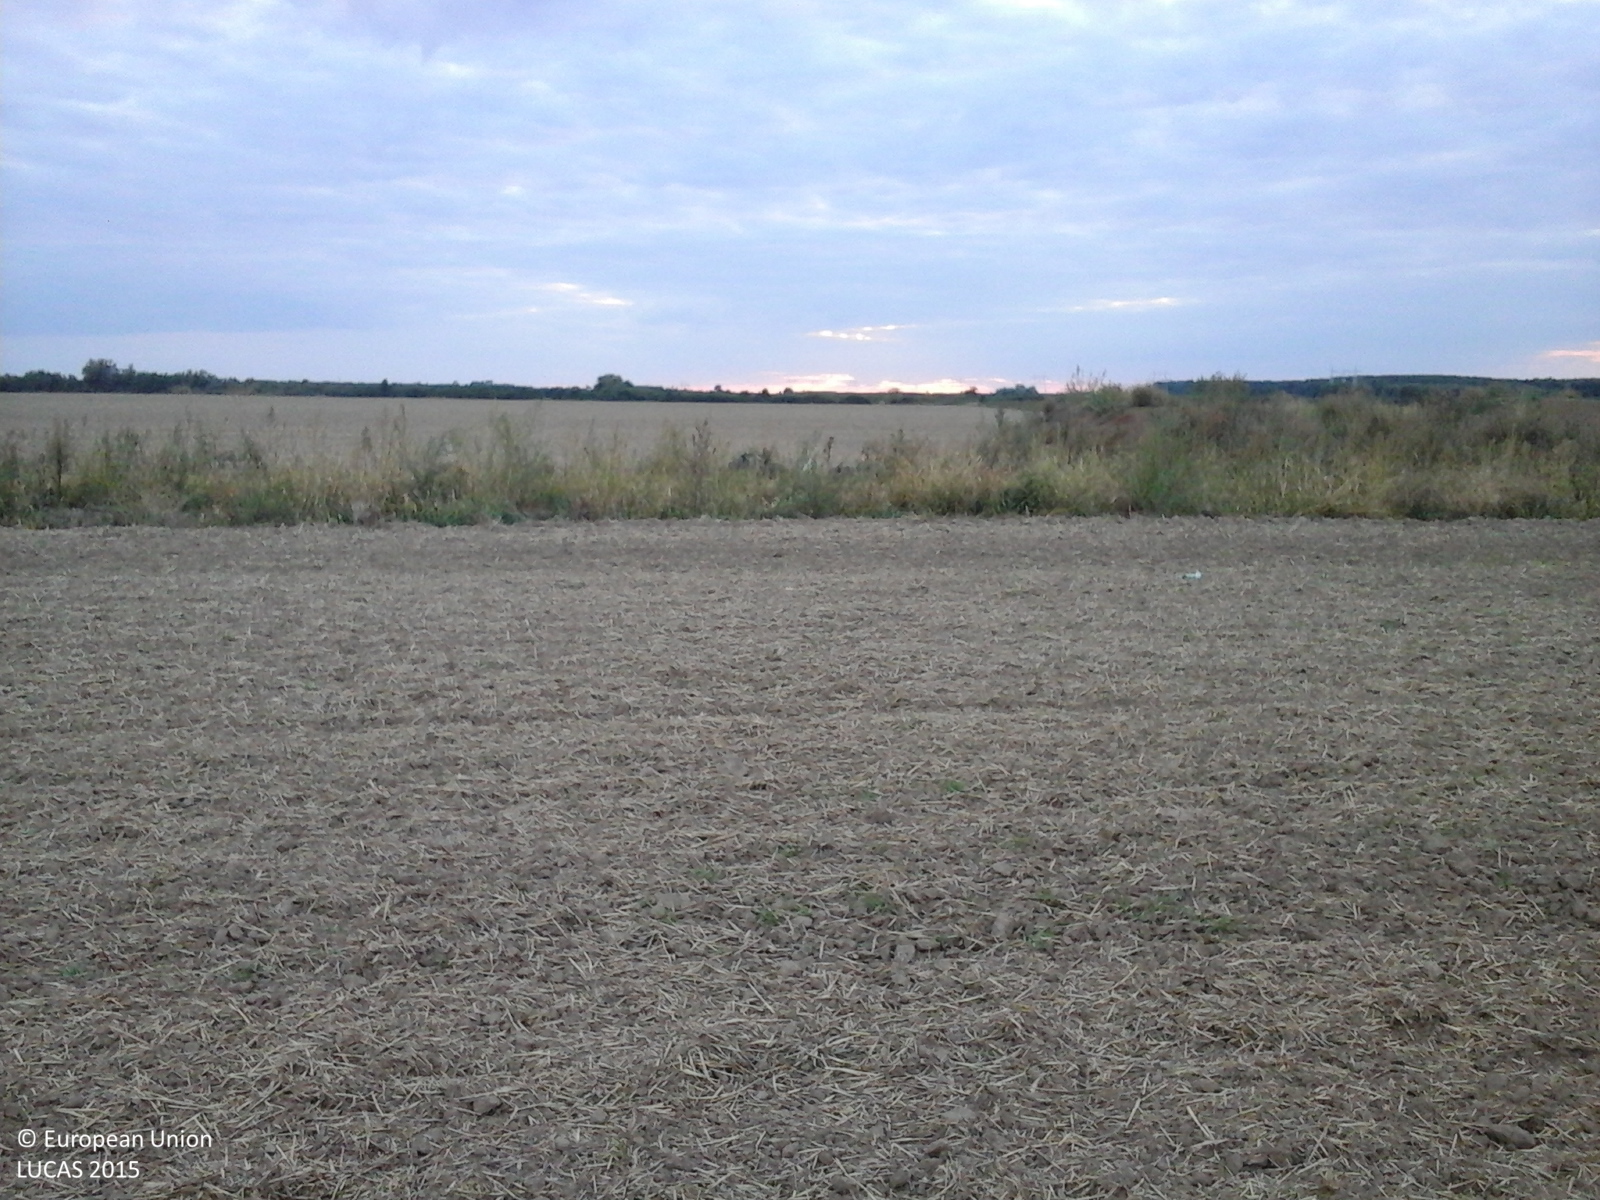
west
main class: Cropland
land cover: Common wheat
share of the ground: < 10 %
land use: Agriculture (excluding fallow land and kitchen gardens)
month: September
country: RO
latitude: 47.5200
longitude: 22.7166
